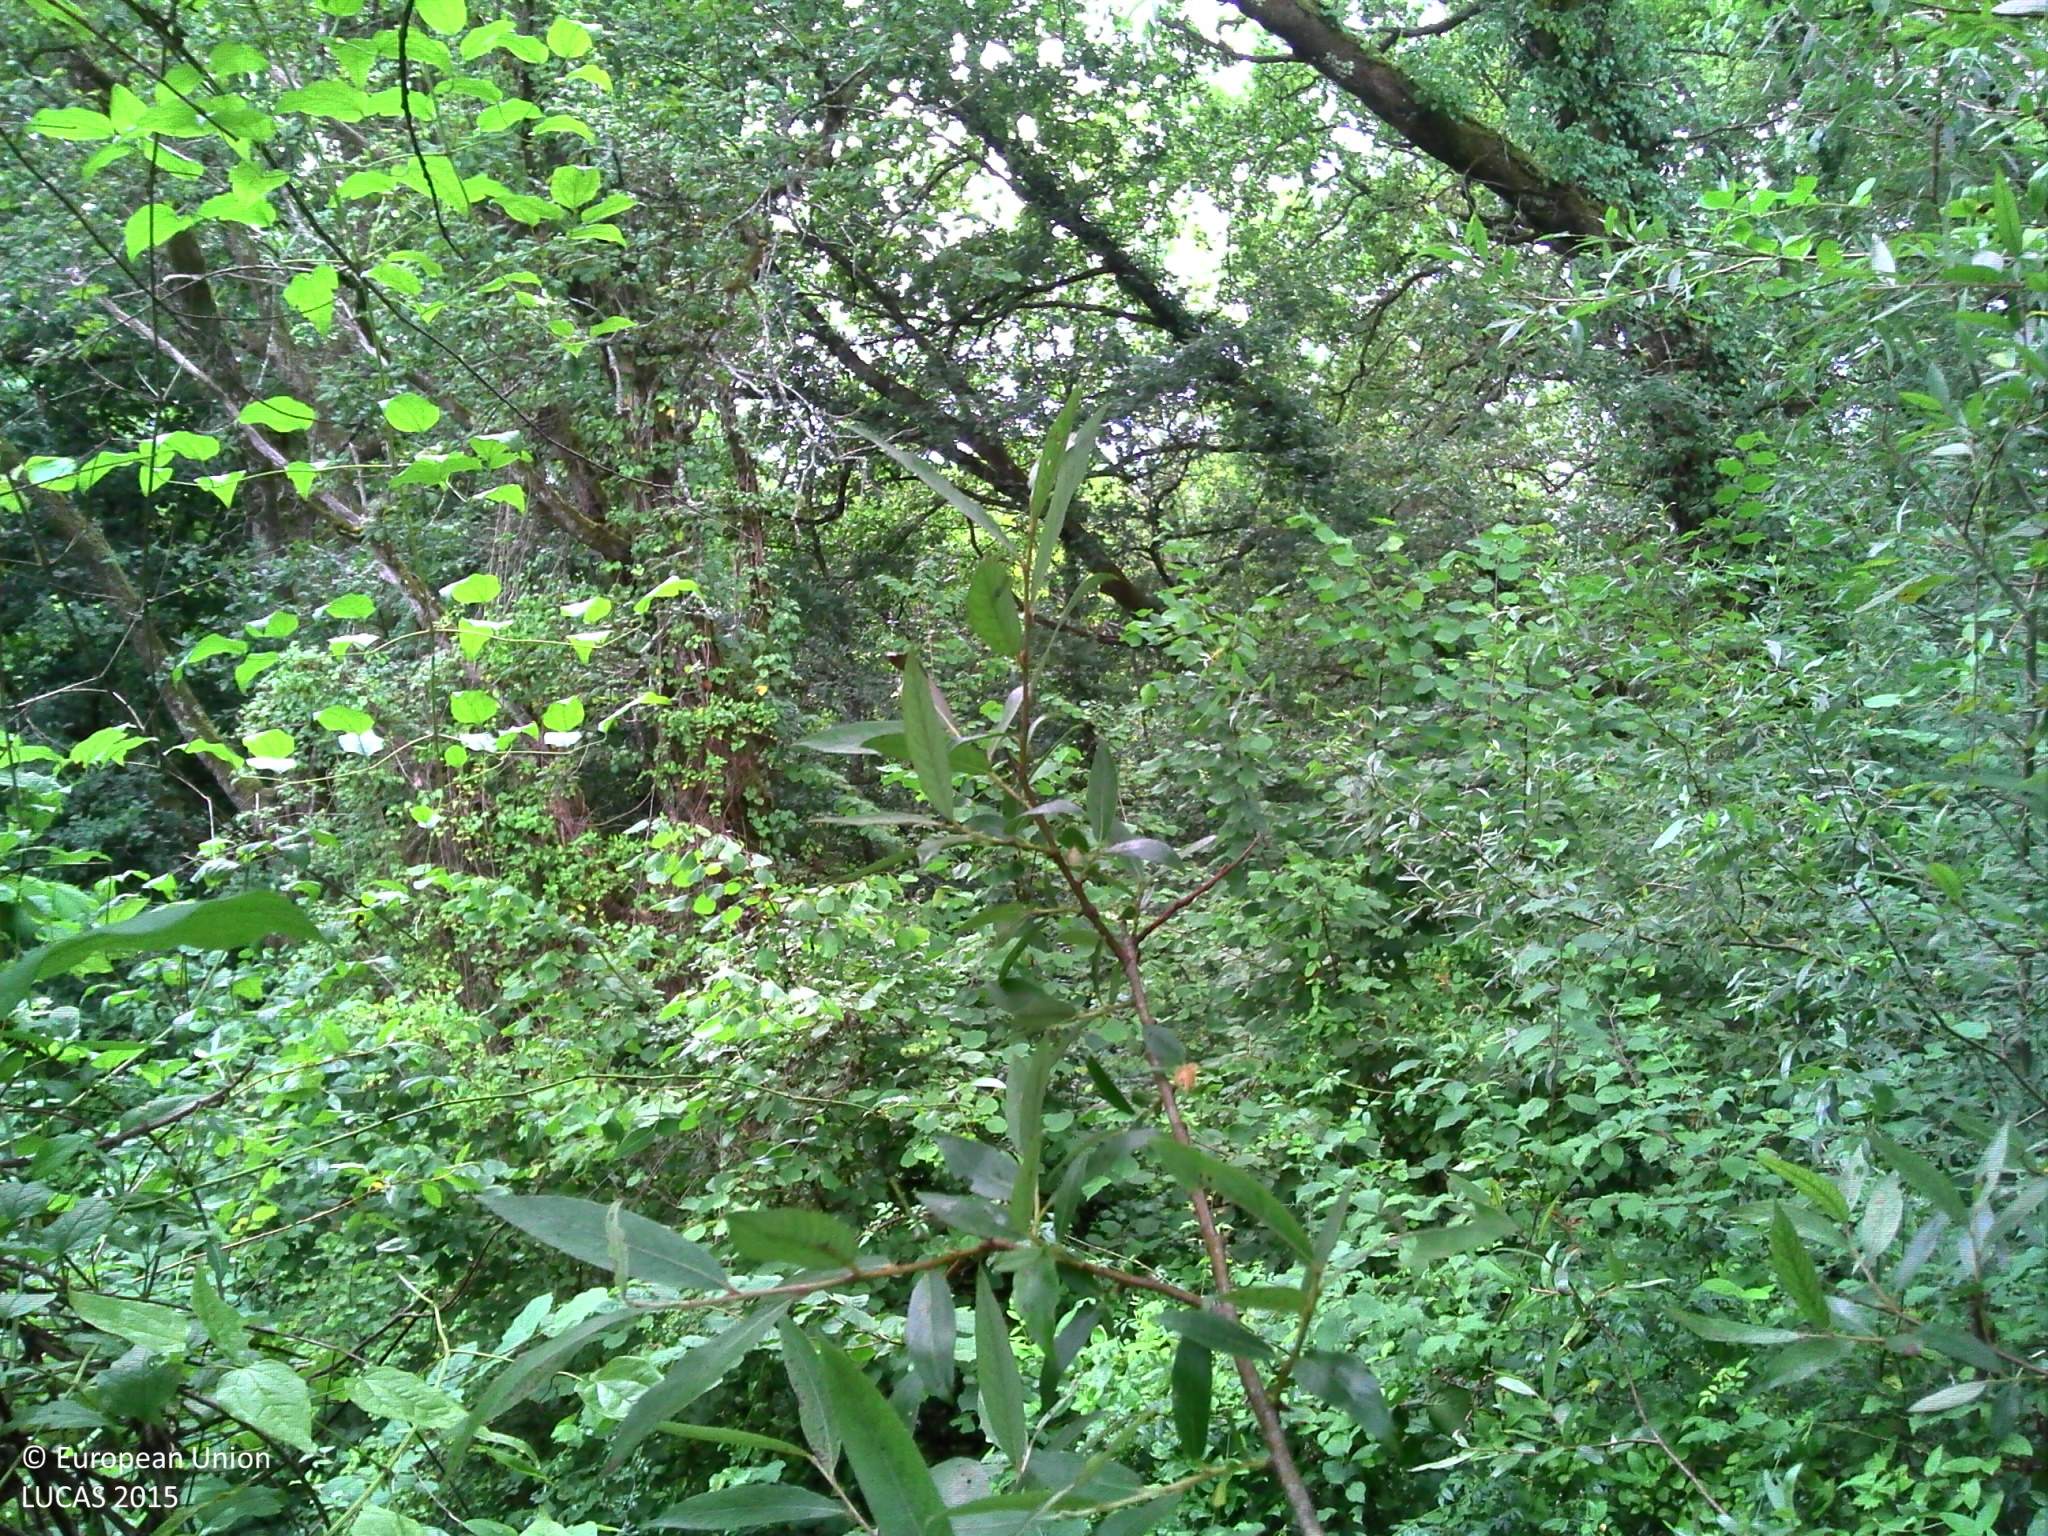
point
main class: Woodland
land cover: Broadleaved woodland
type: mesophytic deciduous forest
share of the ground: > 75 %
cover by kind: broadleaved forest trees 75 %, shrubs 20 %, herbaceous plants 5 %
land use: Forestry
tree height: > 5 m
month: August
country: FR
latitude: 43.4788
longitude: -1.2790
